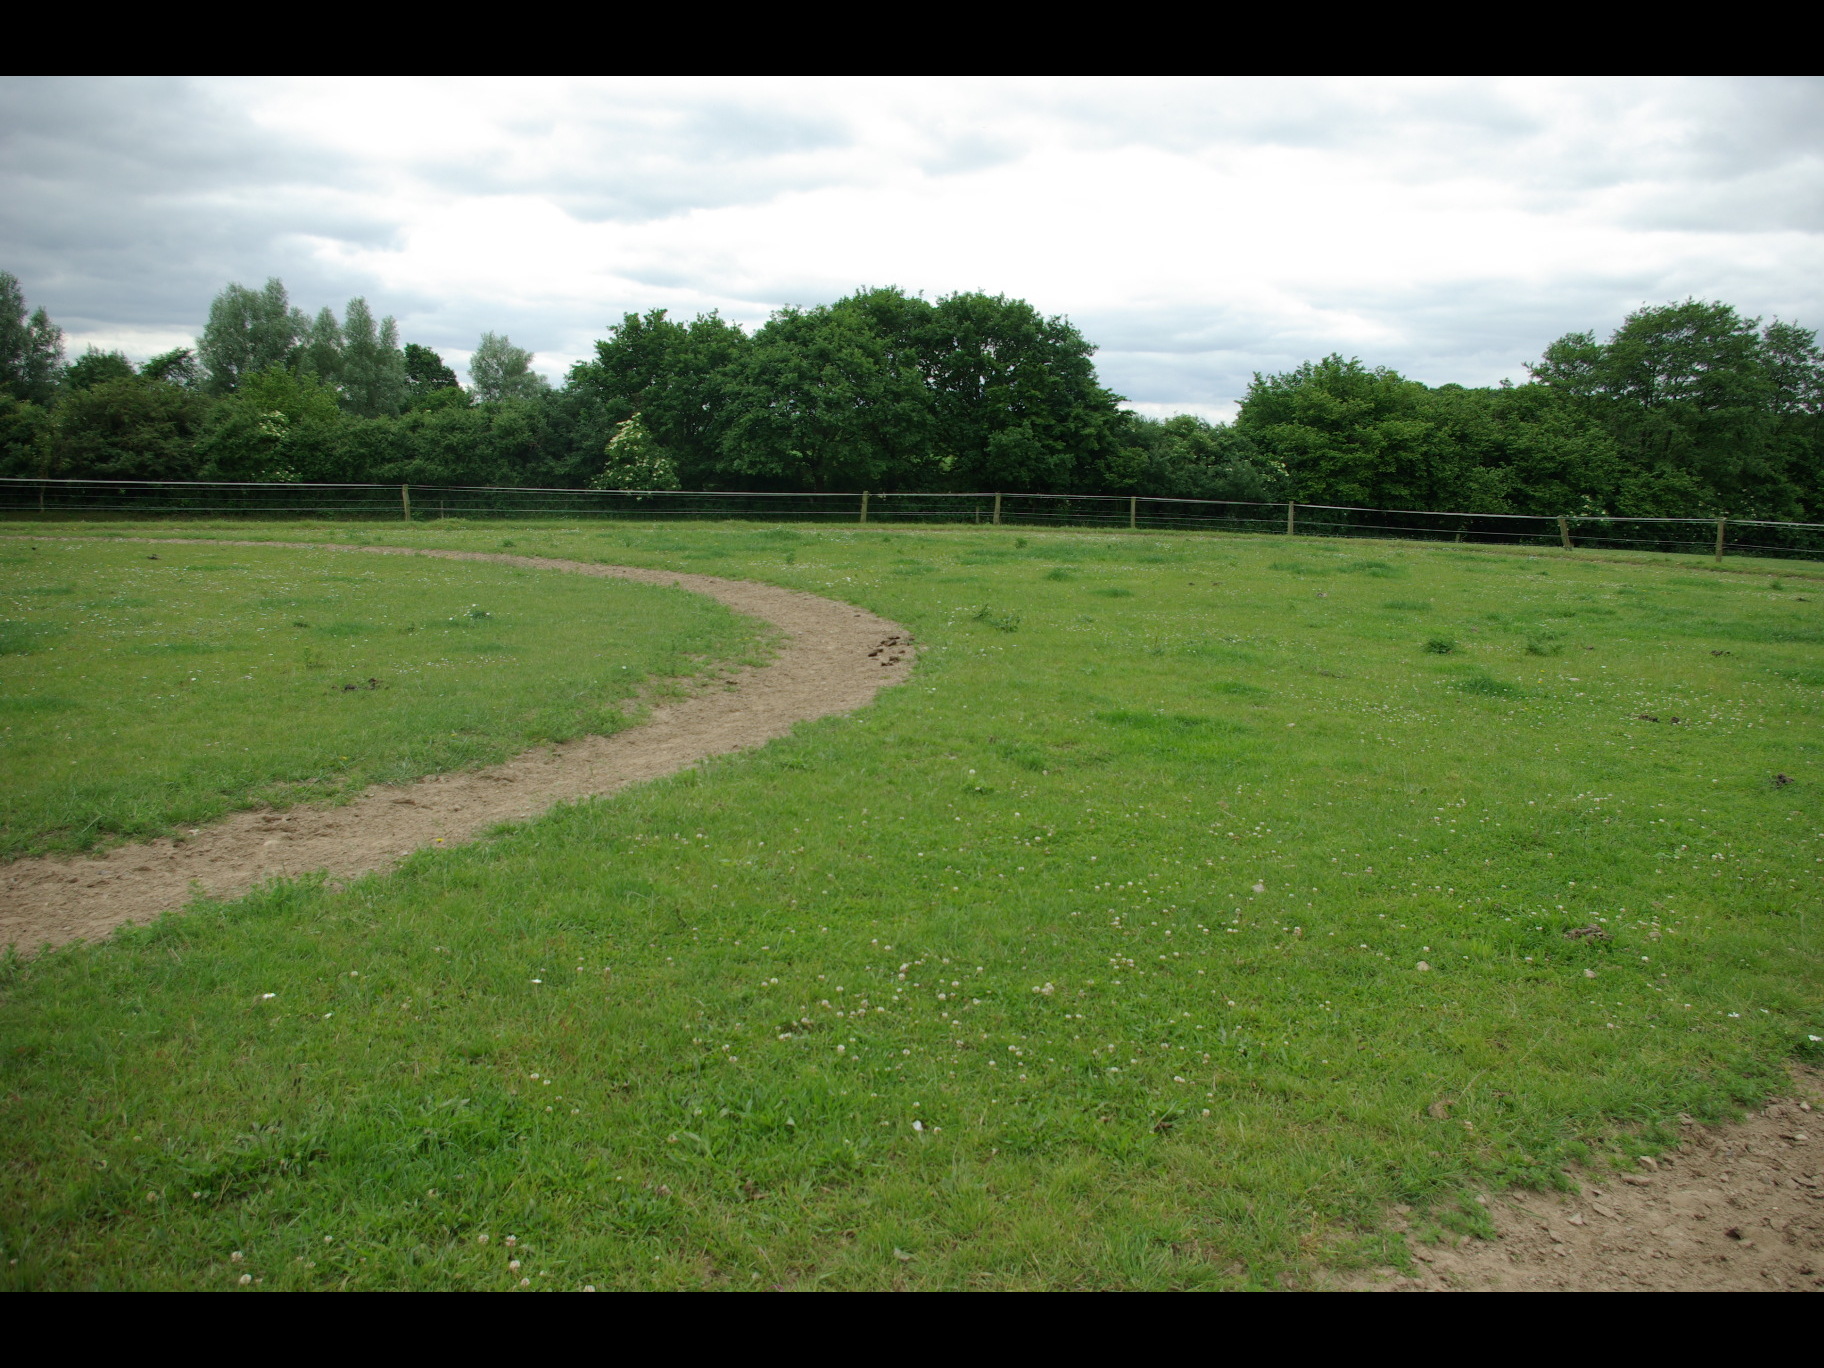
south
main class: Grassland
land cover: Grassland without tree/shrub cover
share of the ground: > 75 %
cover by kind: herbaceous plants 100 %
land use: Agriculture (excluding fallow land and kitchen gardens)
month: June
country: DE
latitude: 54.0489
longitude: 9.8931
